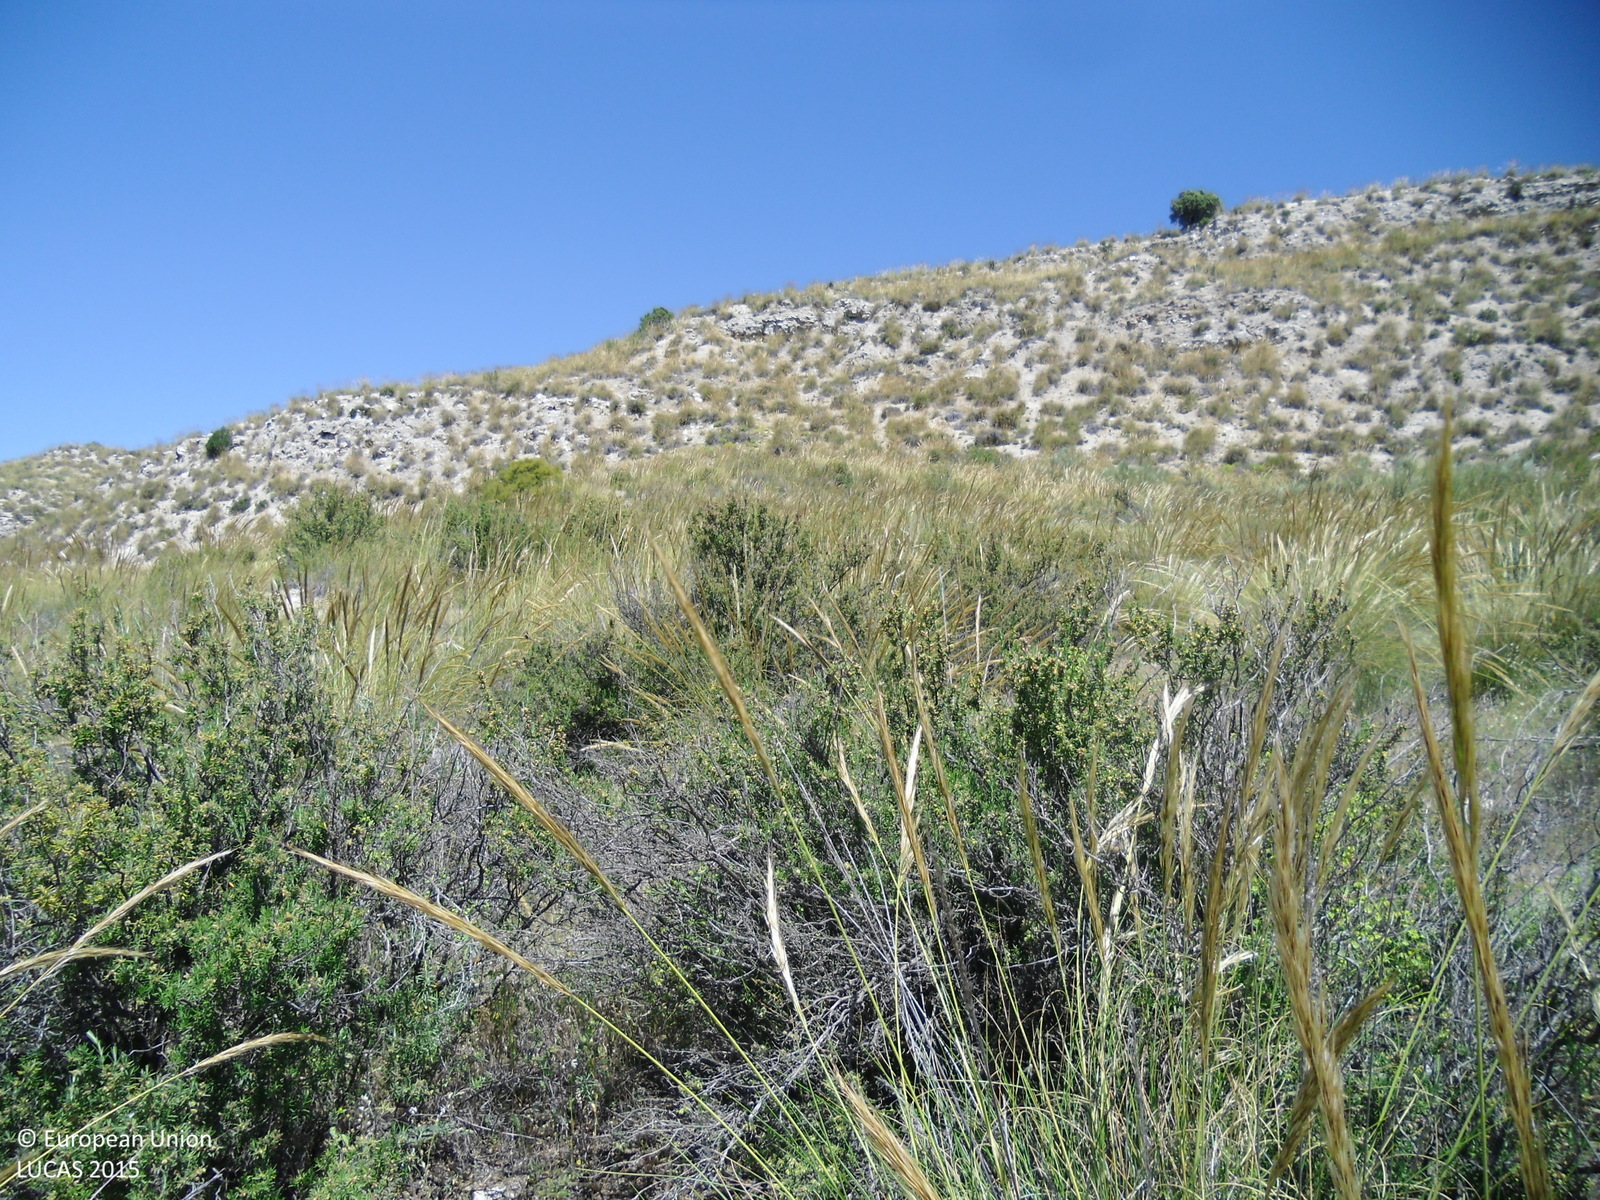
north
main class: Shrubland
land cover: Shrubland without tree cover
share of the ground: > 75 %
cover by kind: shrubs 80 %, herbaceous plants 10 %, consolidated bare surface 10 %
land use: Semi-natural and natural areas not in use
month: May
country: ES
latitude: 40.2295
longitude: -2.9420
